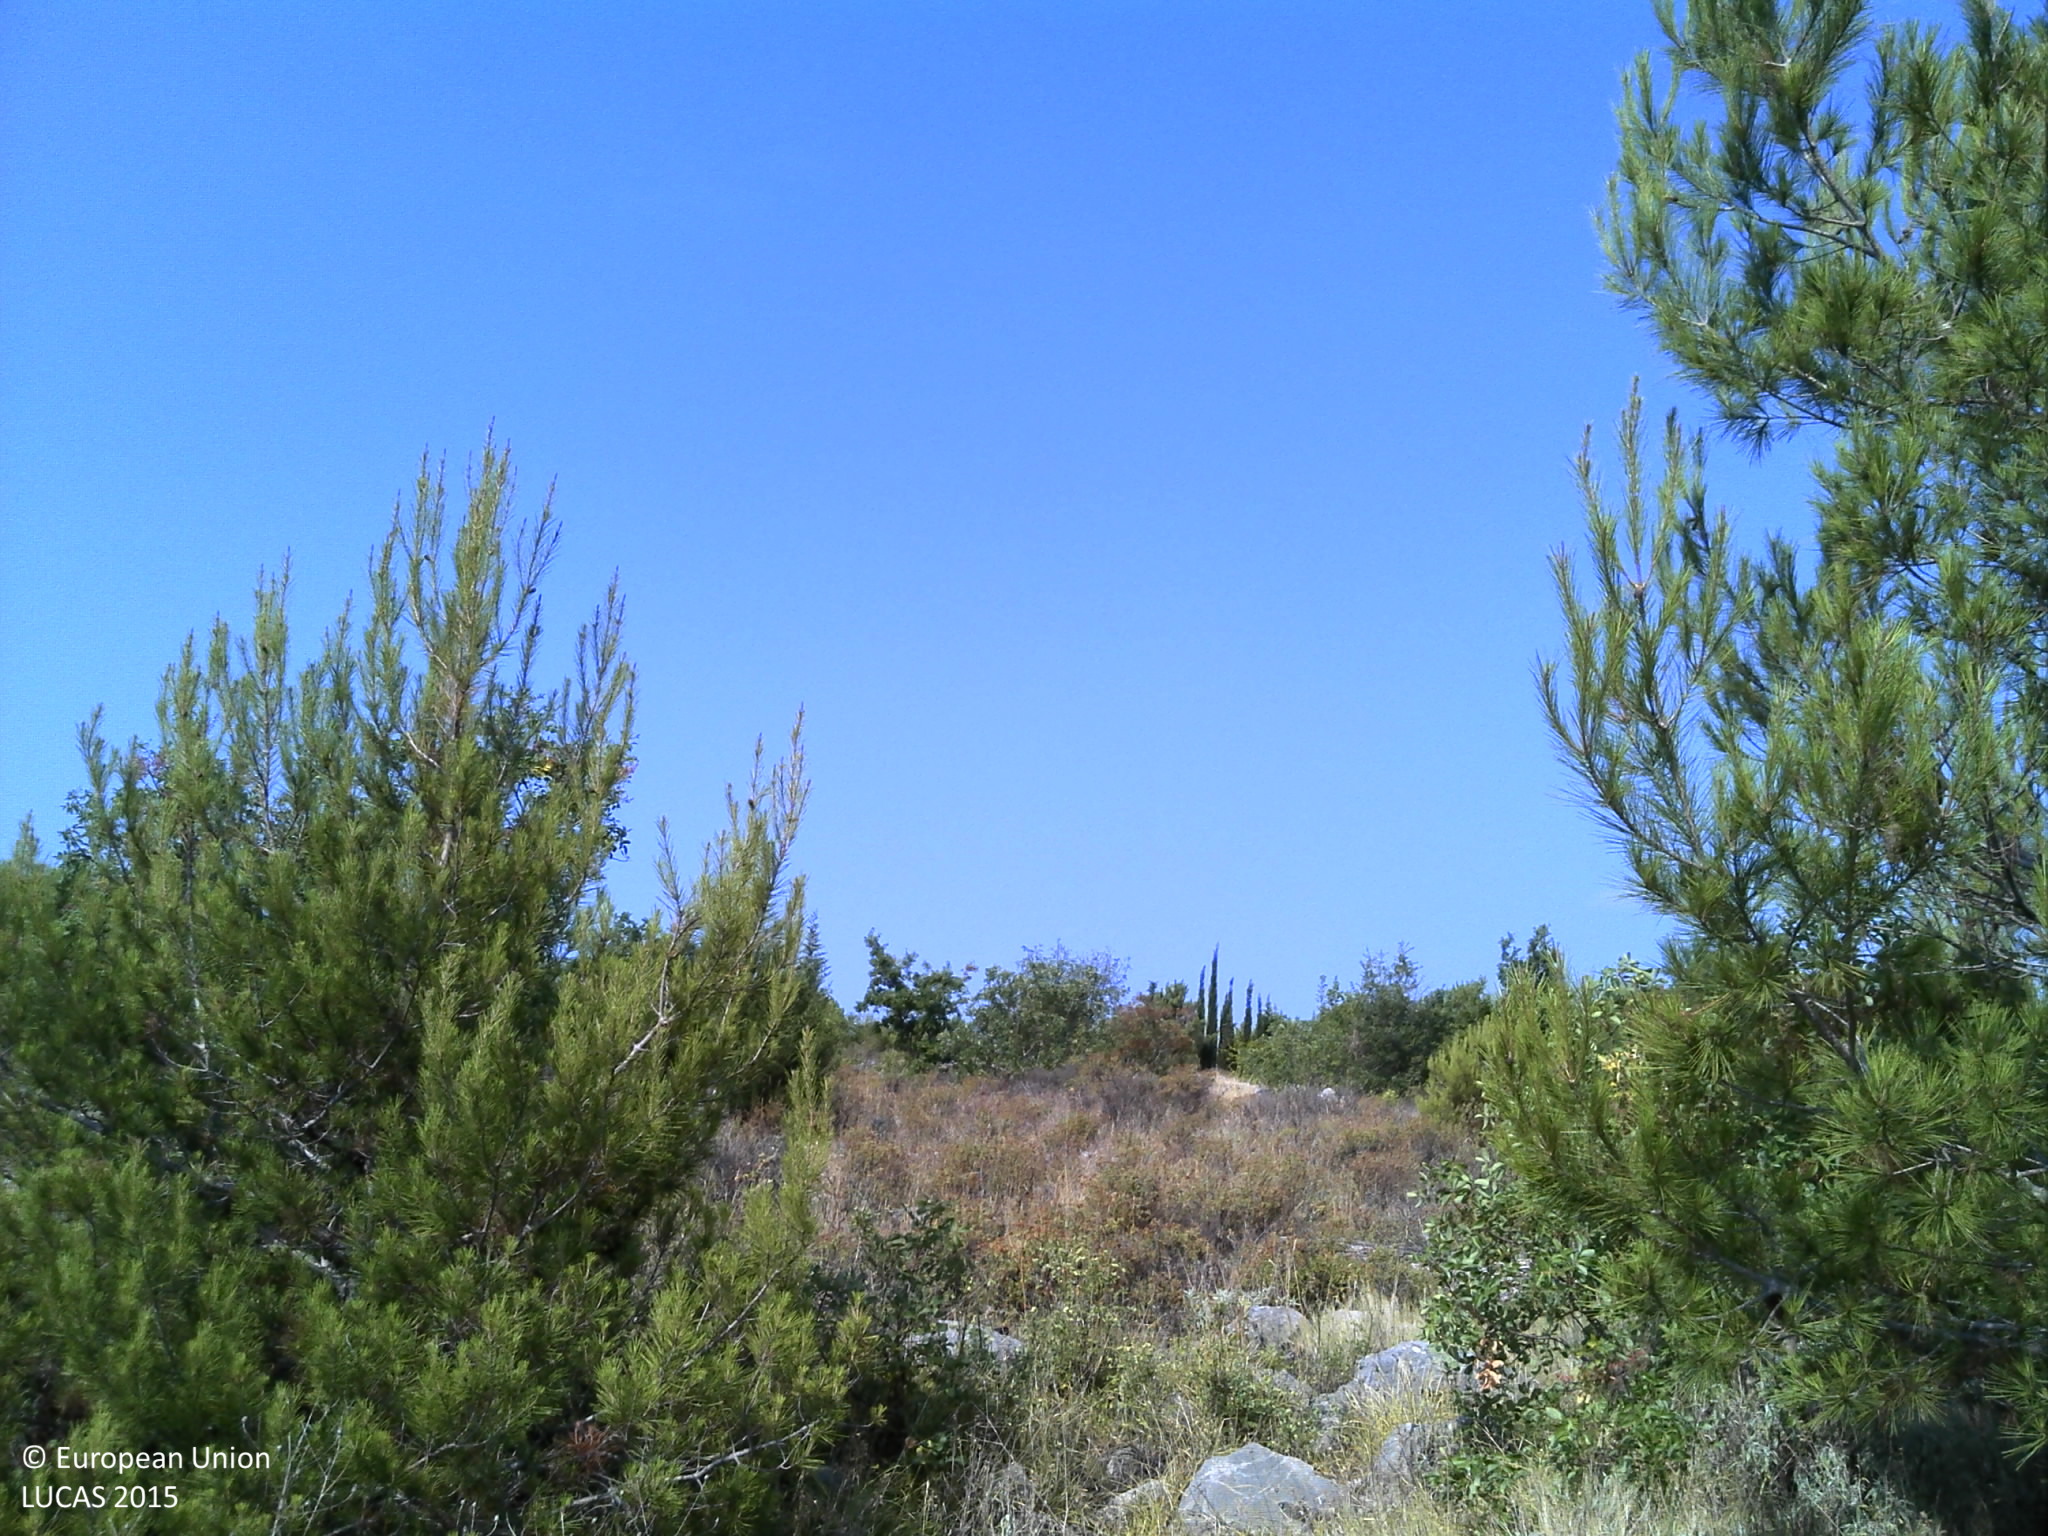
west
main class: Woodland
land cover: Pine dominated coniferous woodland
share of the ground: 10 - 25 %
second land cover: Grassland without tree/shrub cover
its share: > 75 %
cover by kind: consolidated bare surface 35 %, herbaceous plants 30 %, coniferous forest trees 25 %, shrubs 10 %
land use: Agriculture (excluding fallow land and kitchen gardens)
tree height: > 5 m
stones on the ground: 25 - 50 %
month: July
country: HR
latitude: 42.8239
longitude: 17.8065
